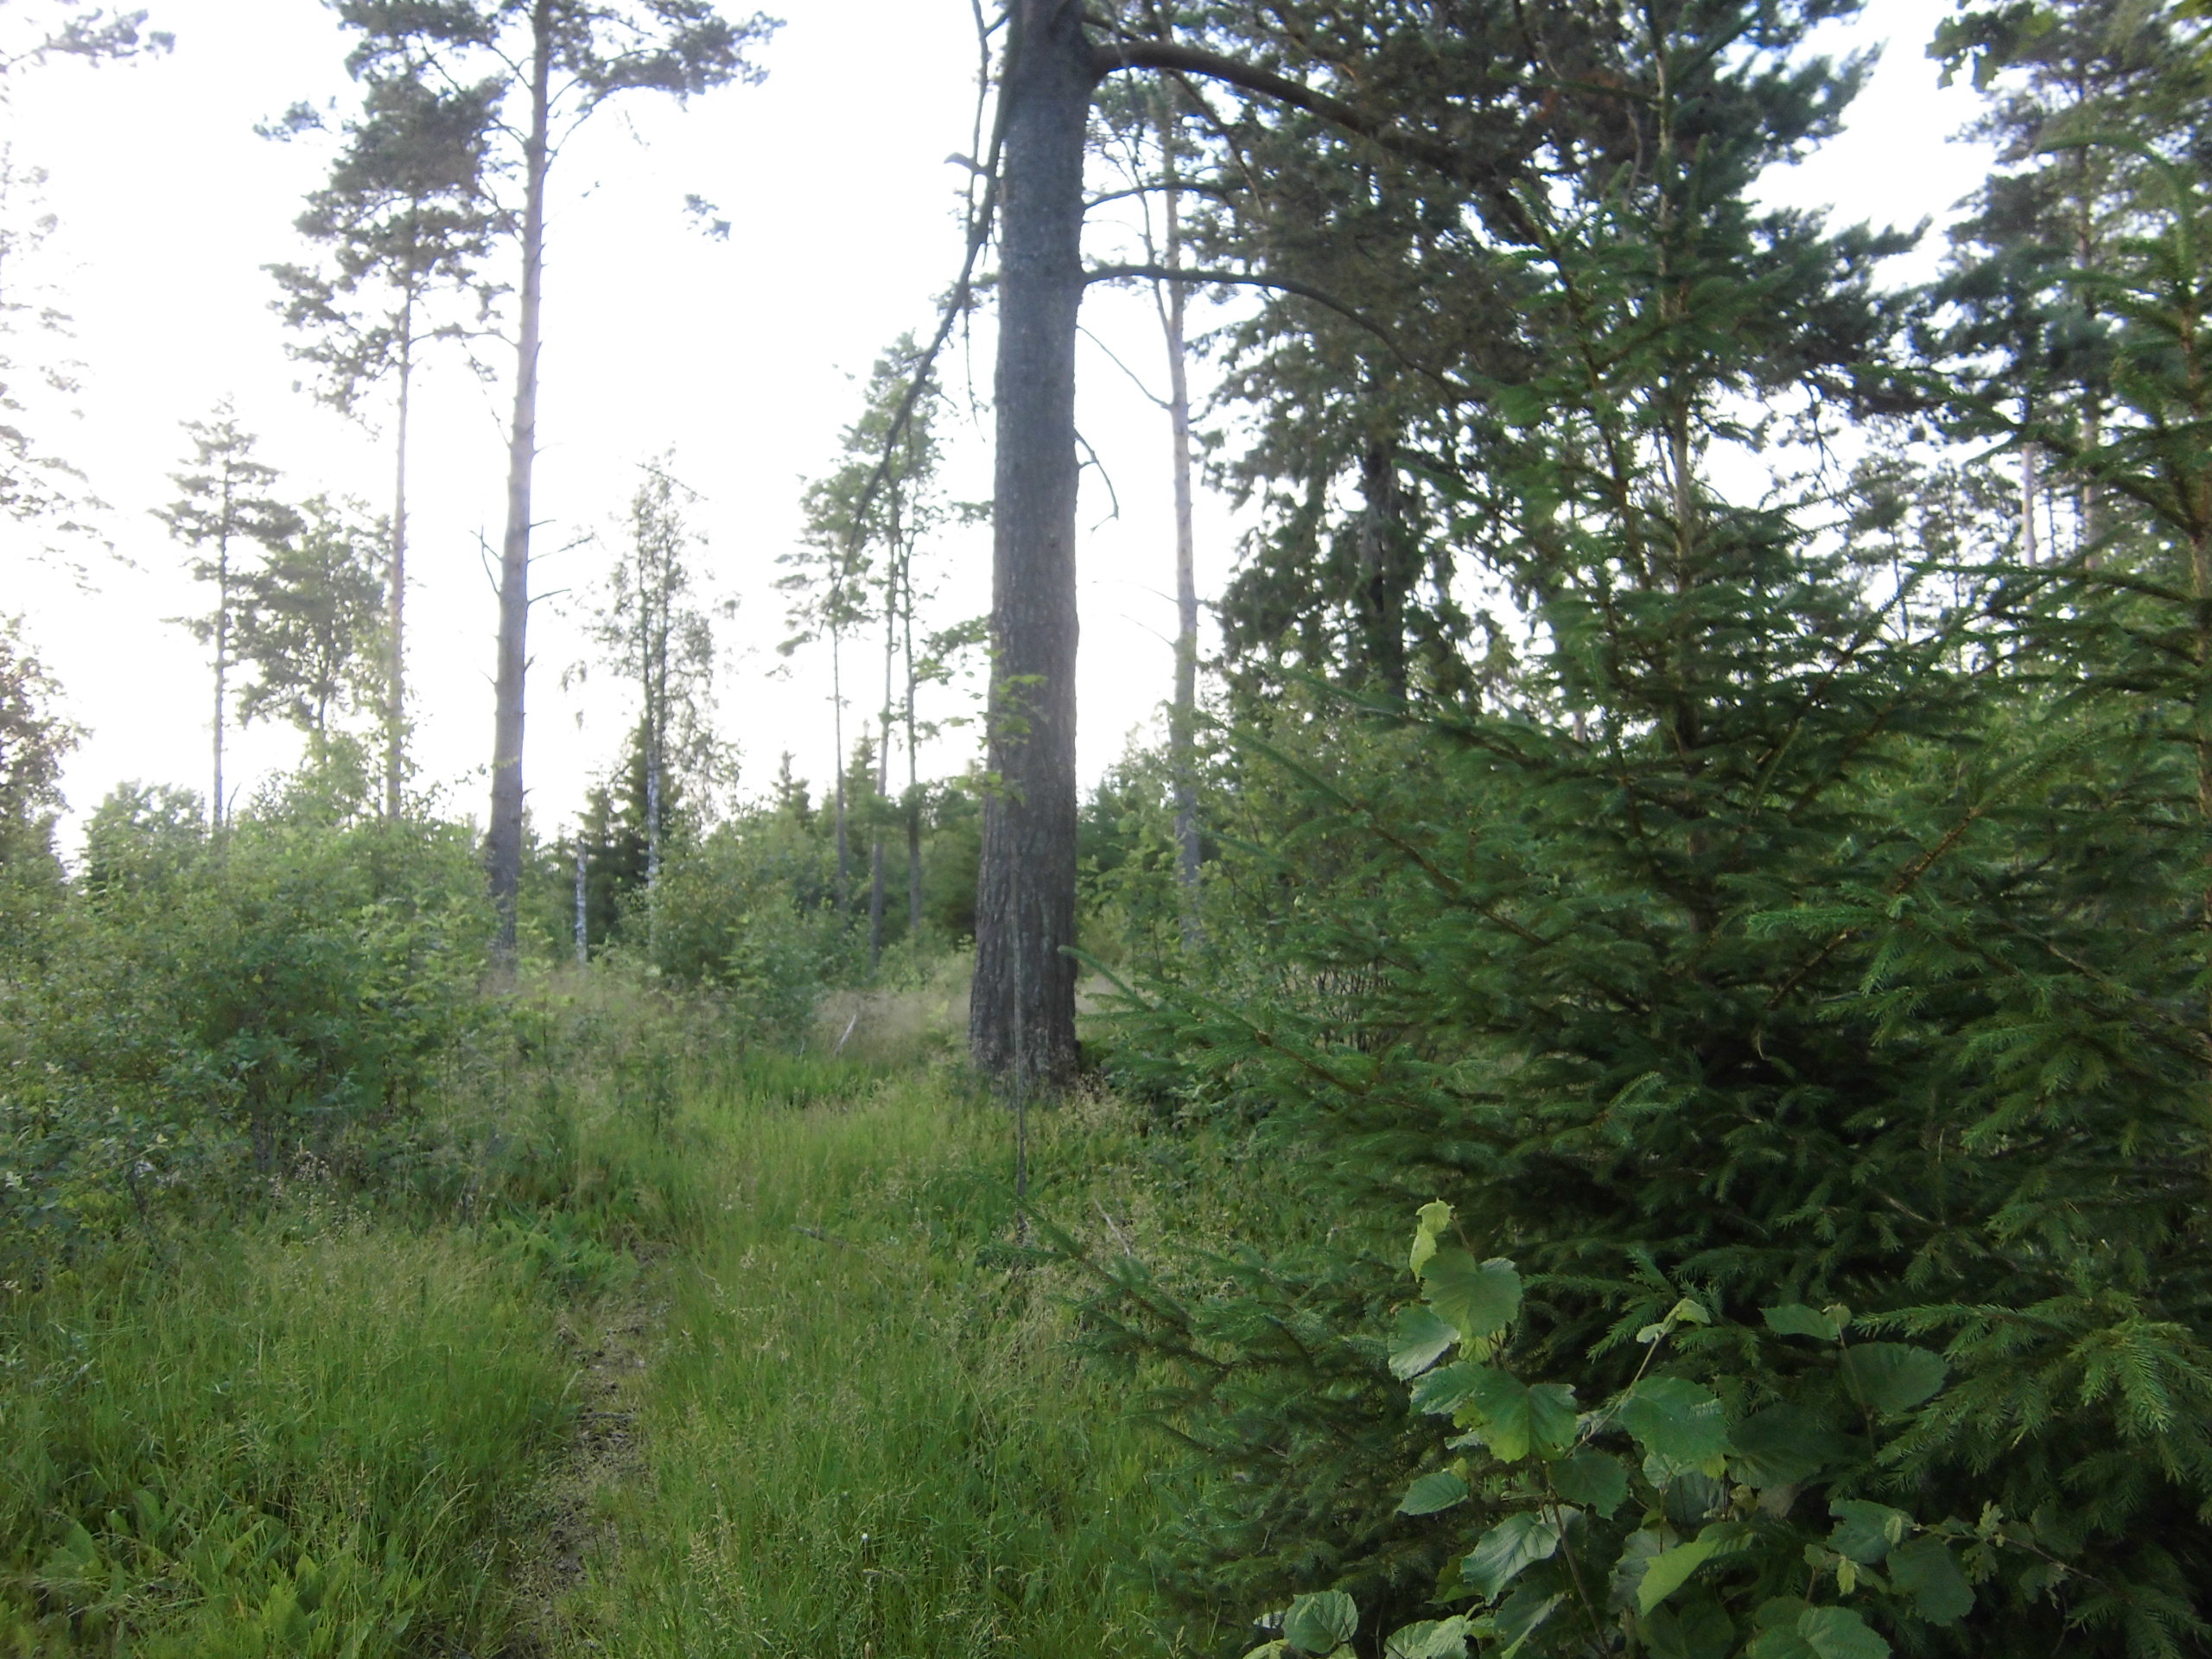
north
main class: Woodland
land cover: Broadleaved woodland
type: hemiboreal forest and nemoral coniferous forest and mixed broadleaved-coniferous forest
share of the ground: 50 - 75 %
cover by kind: broadleaved forest trees 50 %, herbaceous plants 30 %, shrubs 10 %, coniferous forest trees 5 %, lichens and mosses 5 %
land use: Forestry
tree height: > 5 m
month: July
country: SE
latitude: 57.2861
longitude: 14.8241
